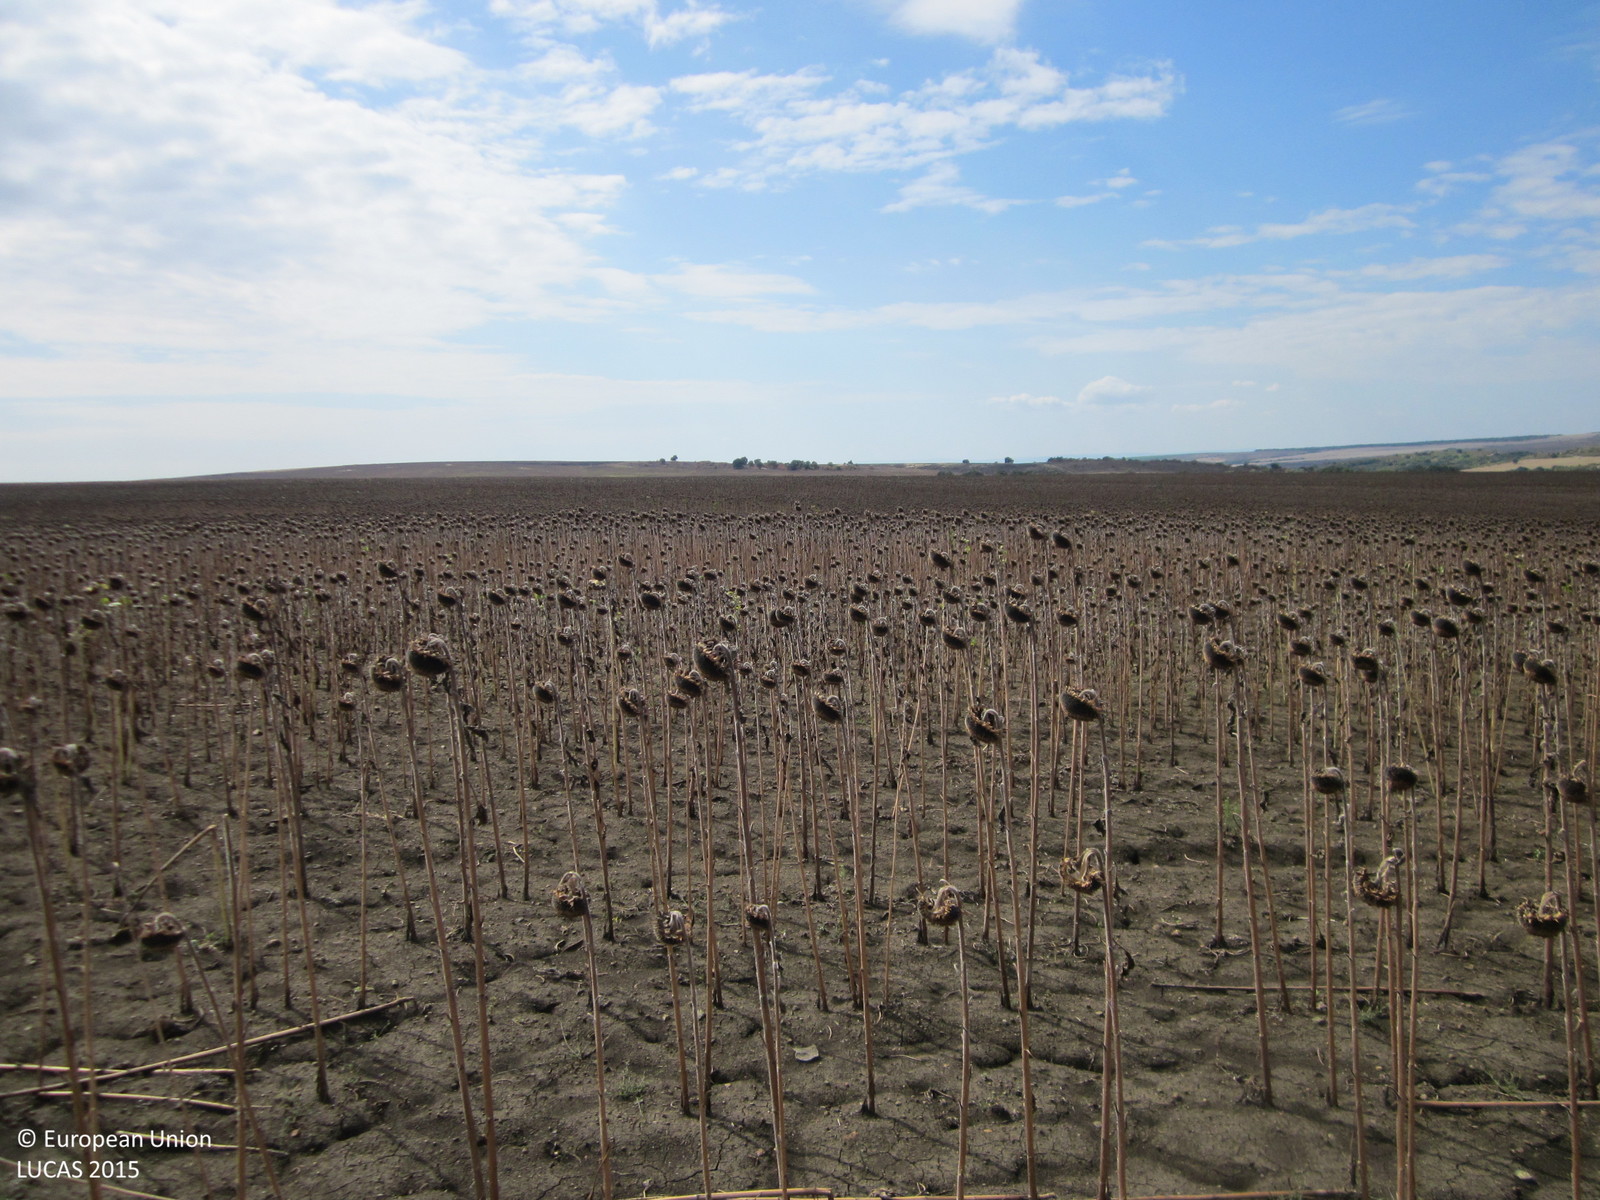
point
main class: Cropland
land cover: Sunflower
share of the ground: 50 - 75 %
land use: Agriculture (excluding fallow land and kitchen gardens)
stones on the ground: < 10 %
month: August
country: BG
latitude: 42.5857
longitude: 27.1068
